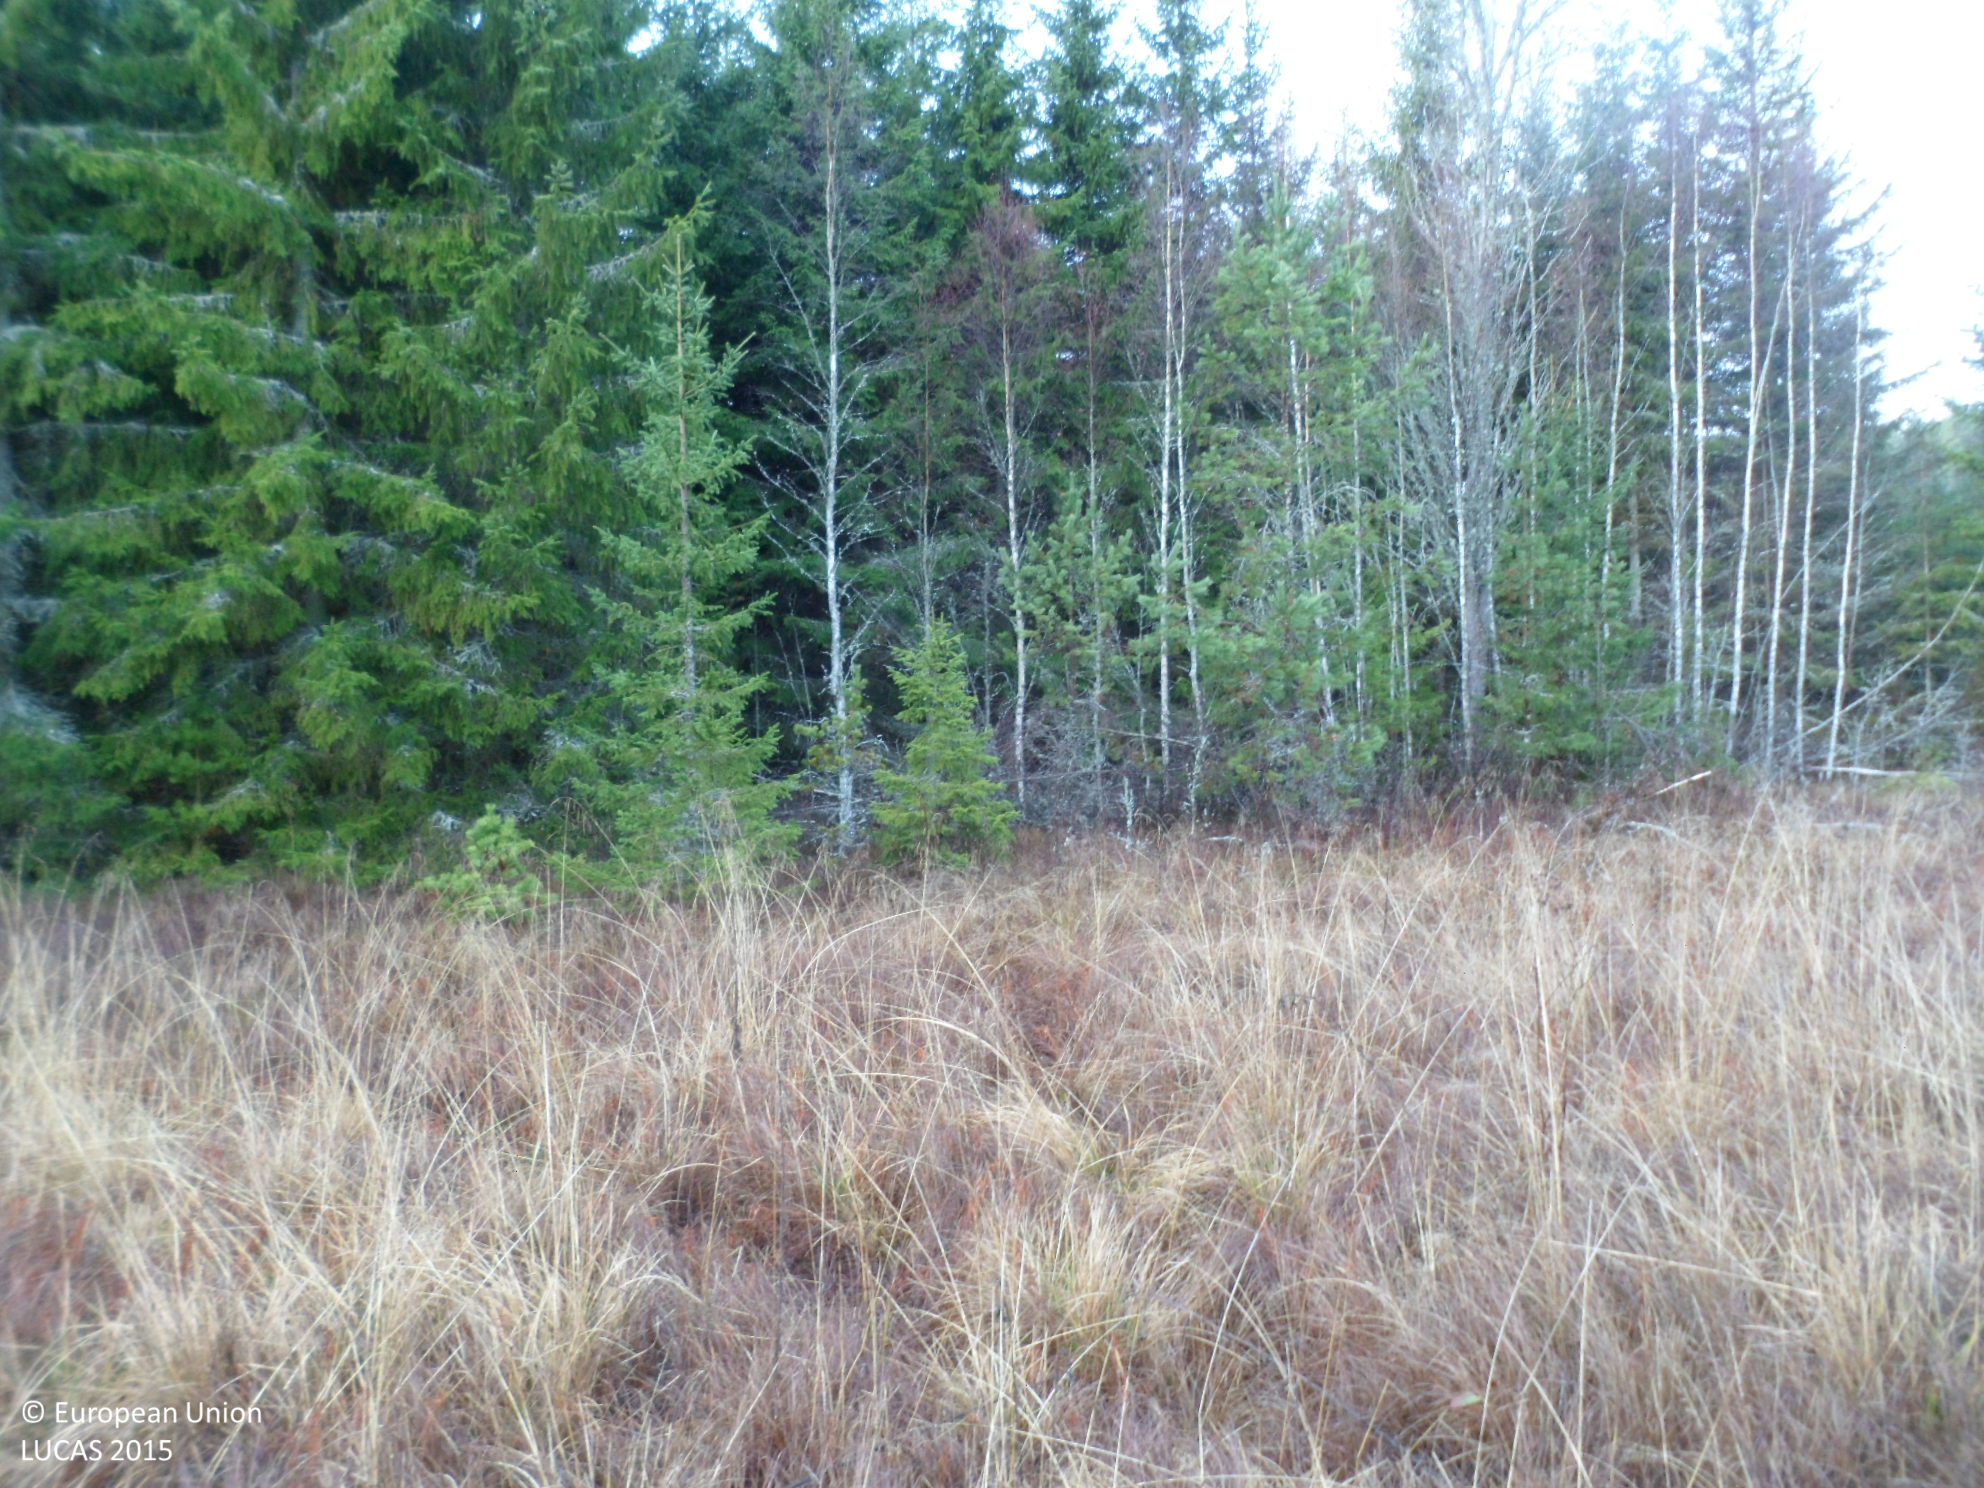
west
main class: Grassland
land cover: Grassland without tree/shrub cover
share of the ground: > 75 %
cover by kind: herbaceous plants 90 %, lichens and mosses 10 %
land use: Agriculture (excluding fallow land and kitchen gardens)
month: November
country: SE
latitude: 57.5461
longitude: 15.9625
